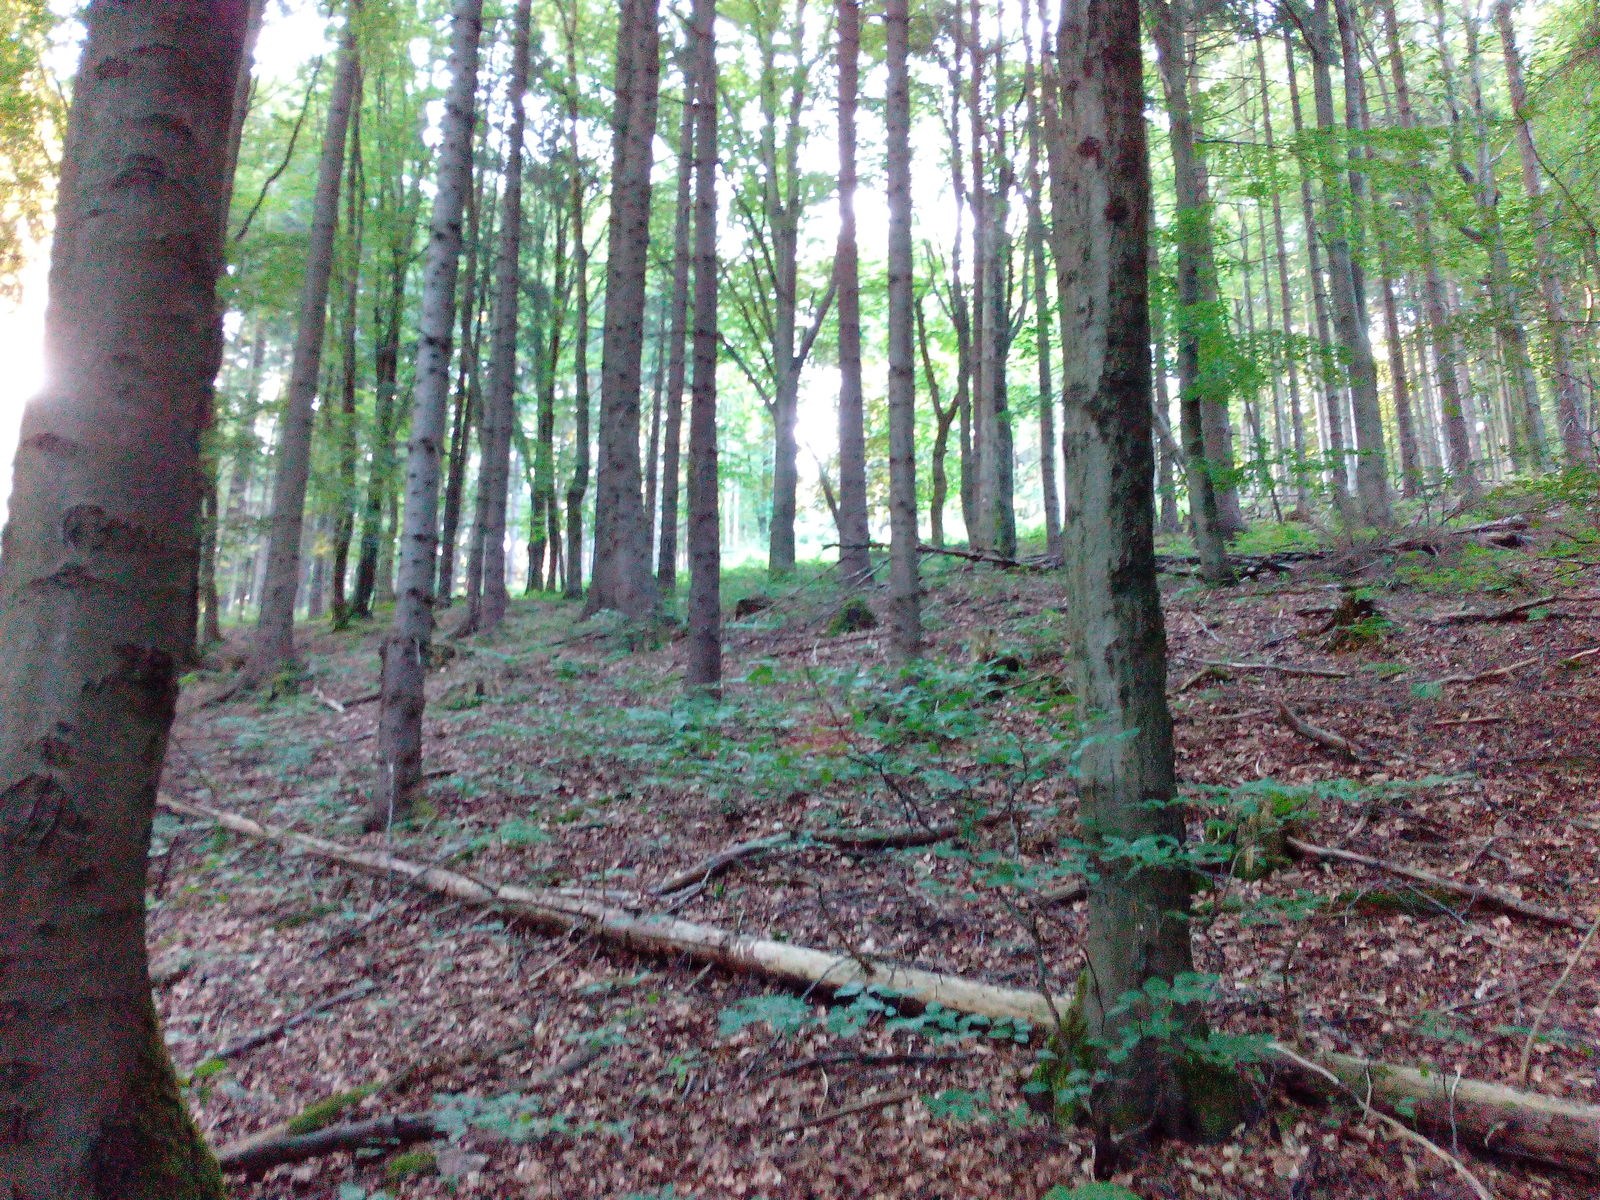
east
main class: Woodland
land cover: Spruce dominated mixed woodland
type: hemiboreal forest and nemoral coniferous forest and mixed broadleaved-coniferous forest
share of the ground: > 75 %
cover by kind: coniferous forest trees 50 %, broadleaved forest trees 50 %
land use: Forestry
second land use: Amenities, museums, leisure
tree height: > 5 m
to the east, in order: Spruce dominated mixed woodland; Tracks; Spruce dominated mixed woodland; Tracks; Spruce dominated mixed woodland; Tracks; Spruce dominated mixed woodland
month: July
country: DE
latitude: 50.6307
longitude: 10.8339
